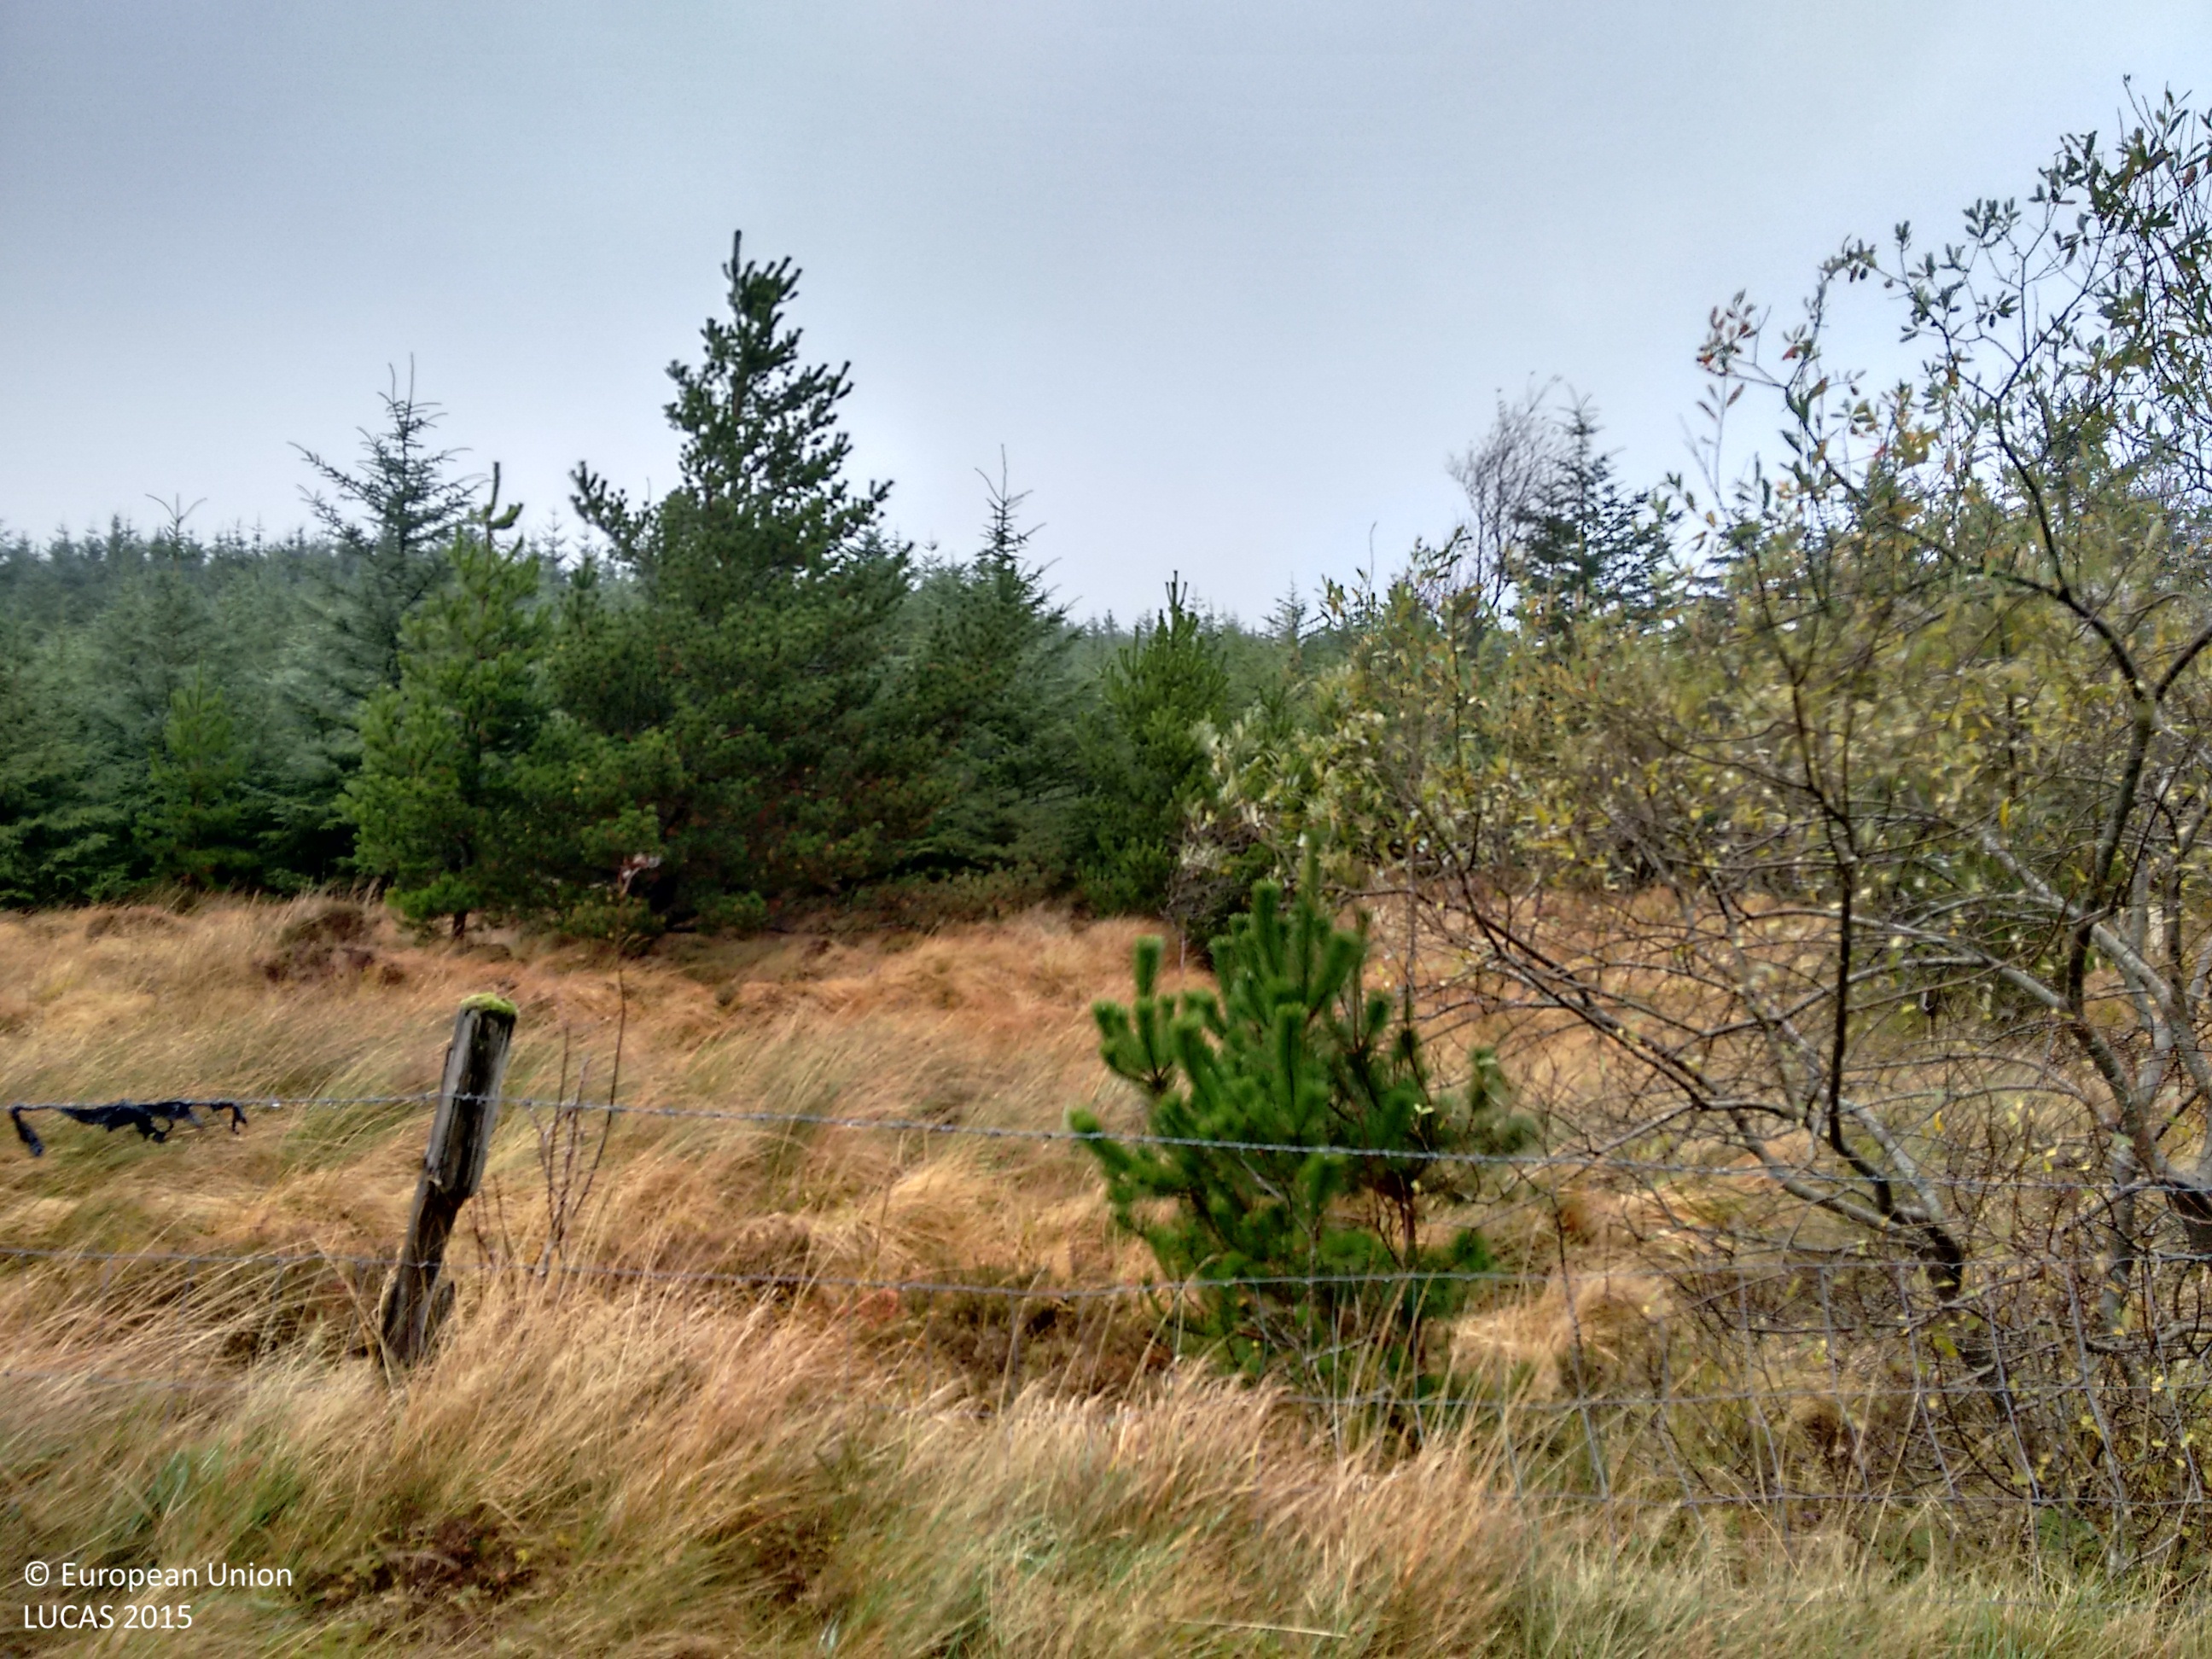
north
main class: Woodland
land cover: Spruce dominated coniferous woodland
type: exotic forest
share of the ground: > 75 %
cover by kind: coniferous forest trees 90 %, herbaceous plants 10 %
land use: Forestry
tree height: > 5 m
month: November
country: IE
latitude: 54.8239
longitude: -8.2517
